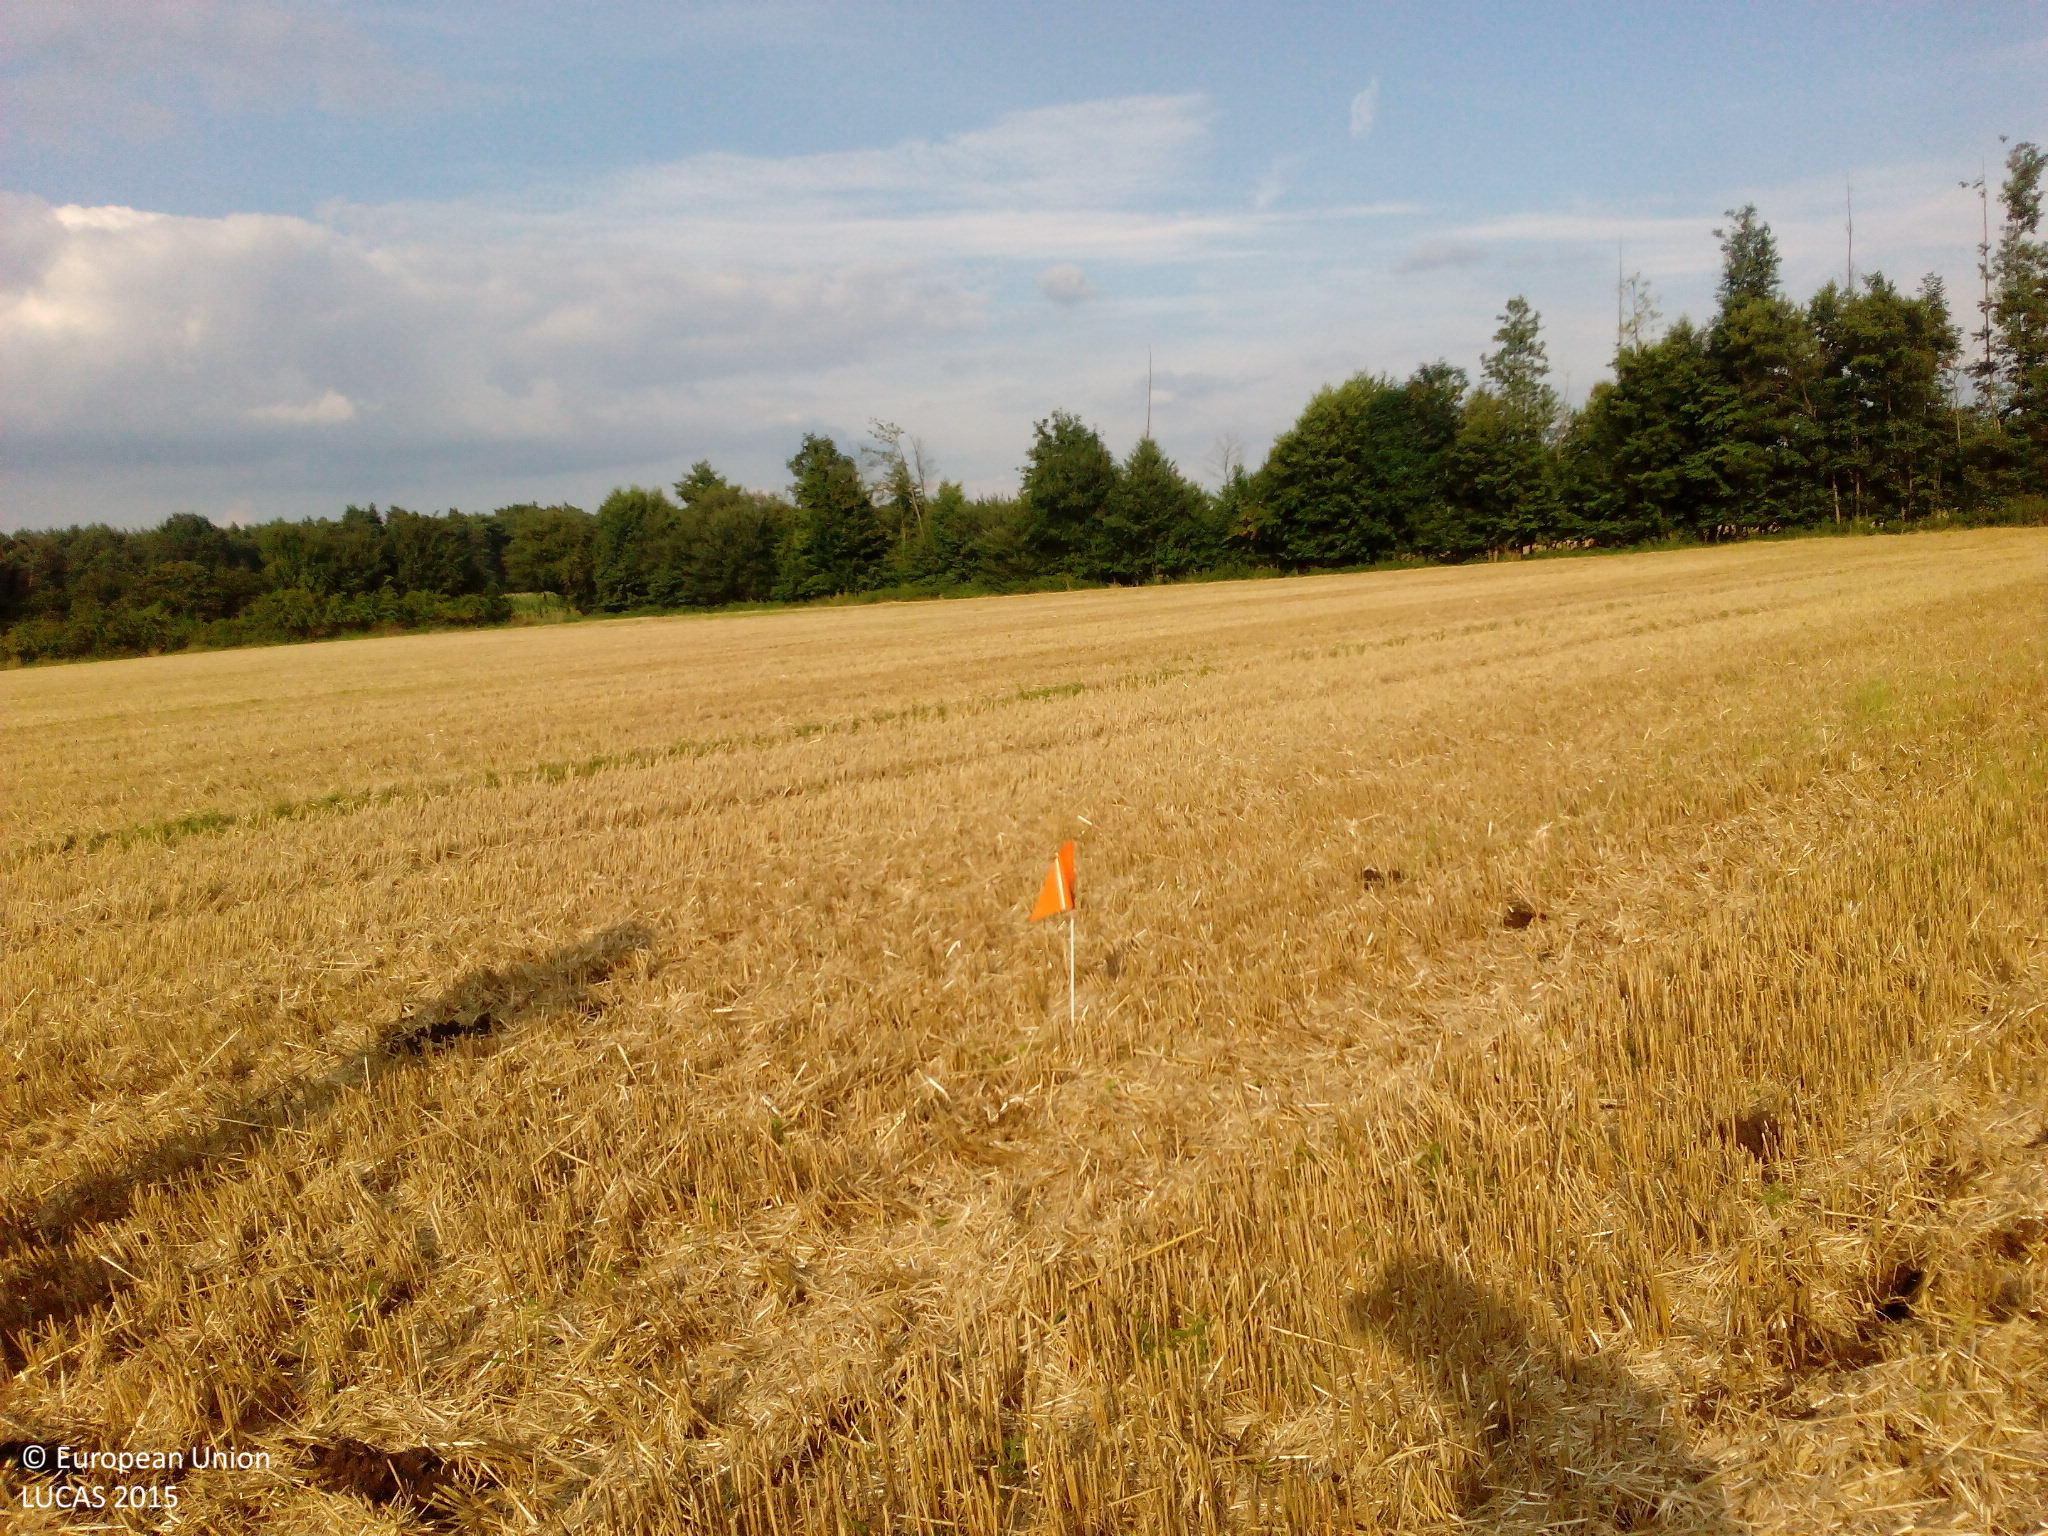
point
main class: Cropland
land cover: Barley
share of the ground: 50 - 75 %
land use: Agriculture (excluding fallow land and kitchen gardens)
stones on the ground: < 10 %
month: August
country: DE
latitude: 52.1094
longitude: 8.0292
